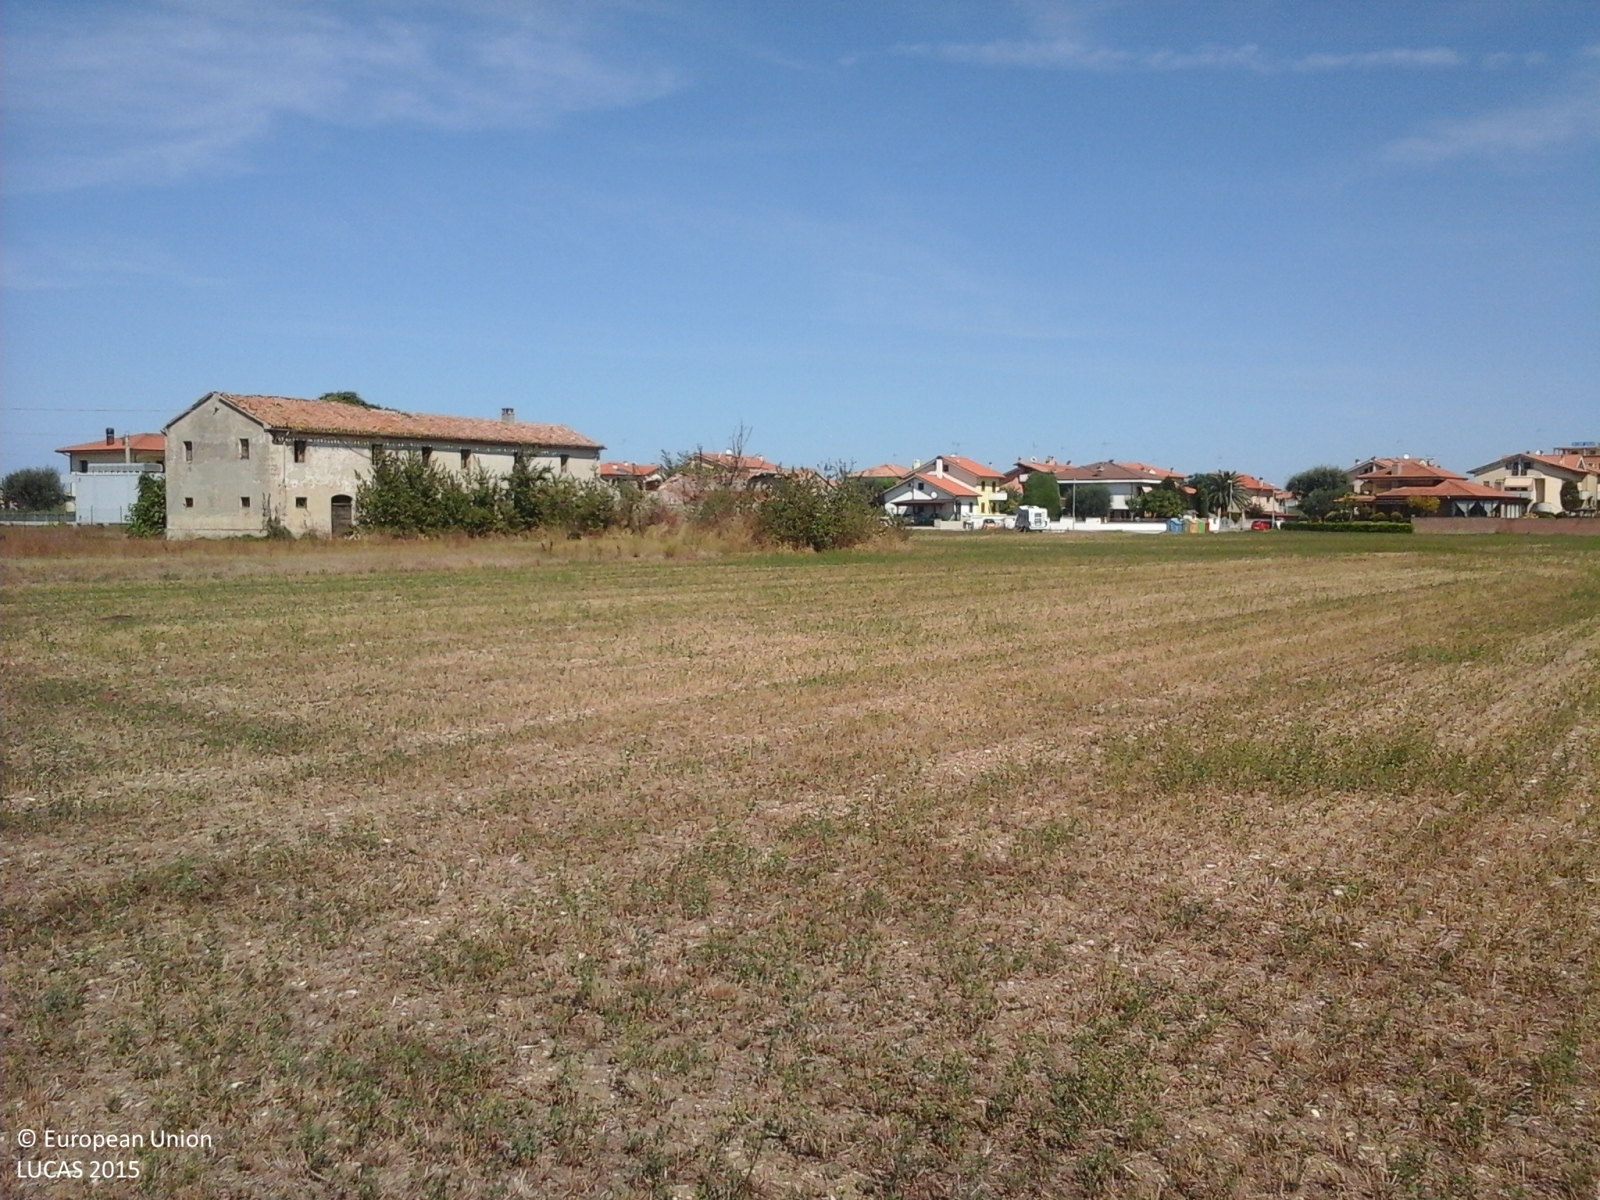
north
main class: Cropland
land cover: Lucerne
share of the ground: > 75 %
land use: Agriculture (excluding fallow land and kitchen gardens)
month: September
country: IT
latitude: 43.7992
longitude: 13.0876
